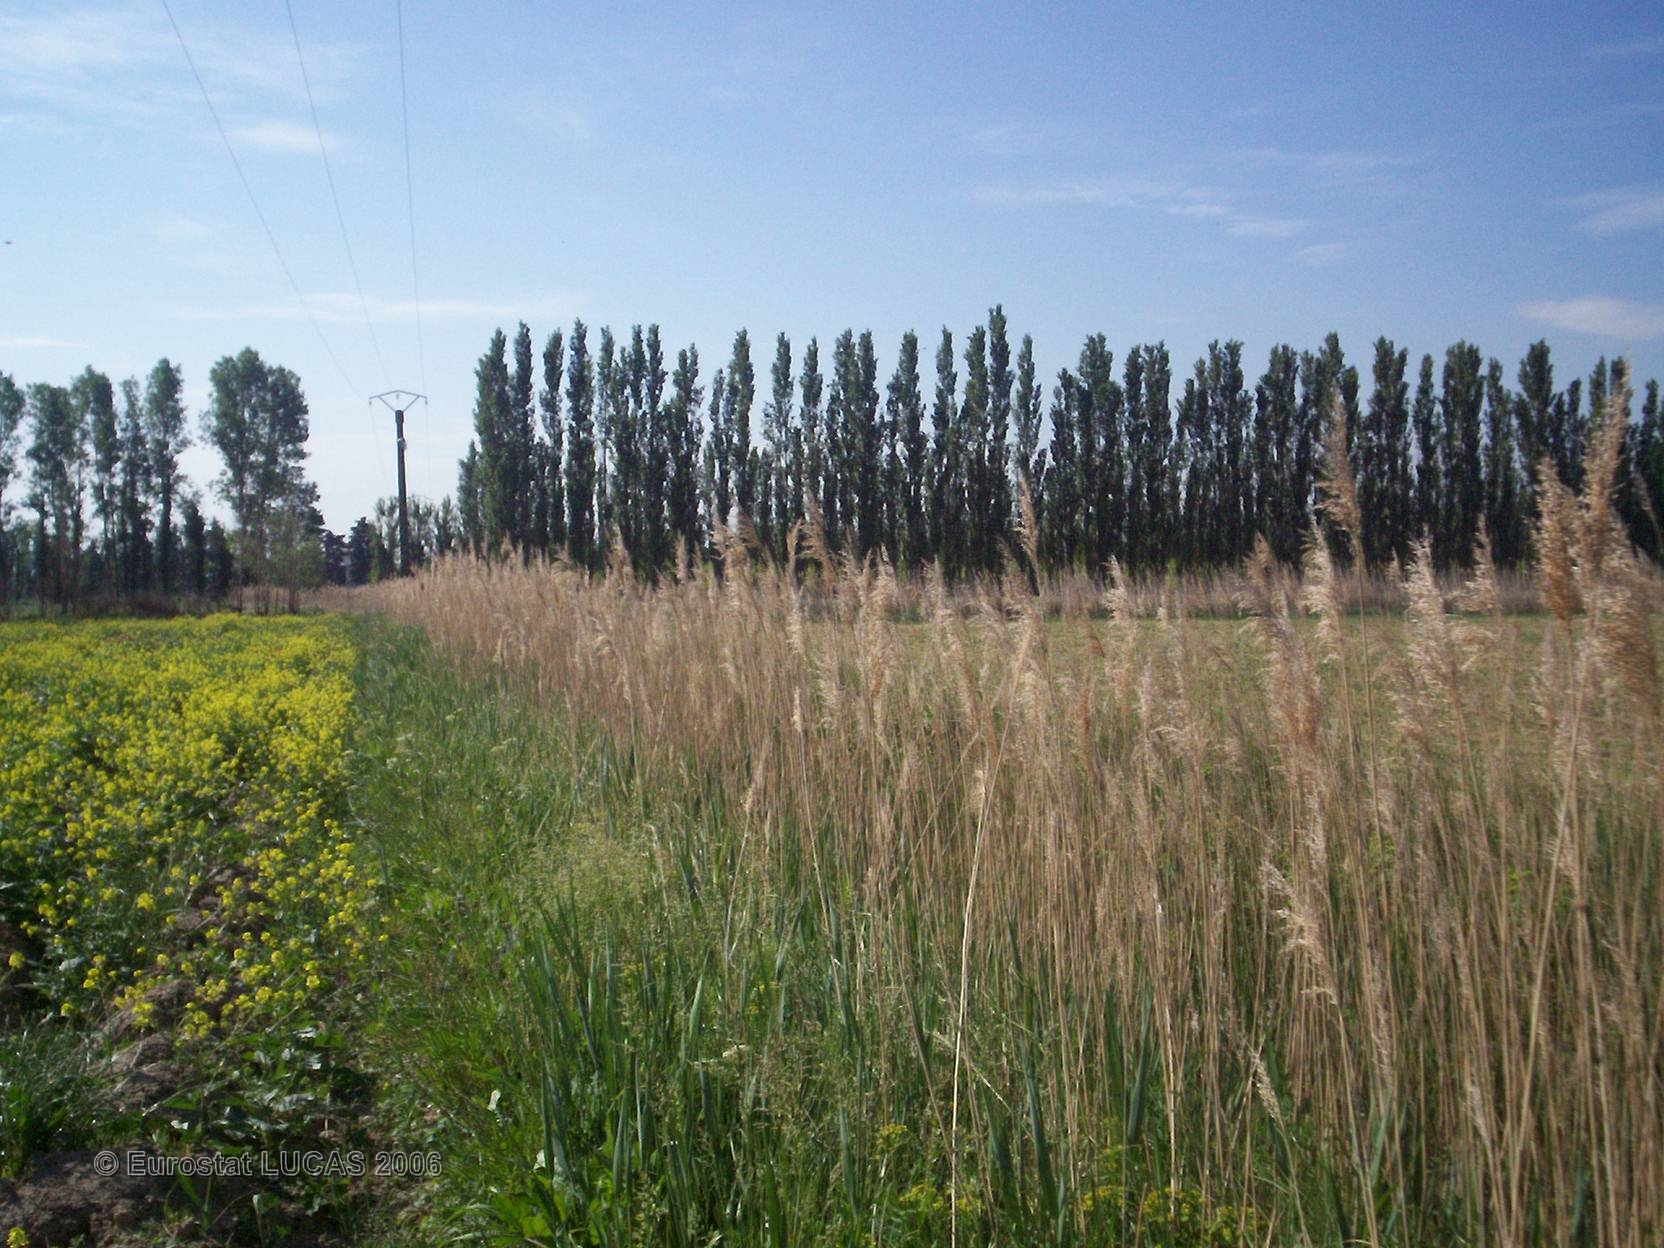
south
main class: Grassland
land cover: Grassland without tree/shrub cover
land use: Agriculture (excluding fallow land and kitchen gardens)
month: May
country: FR
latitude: 44.0651
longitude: 4.9520
